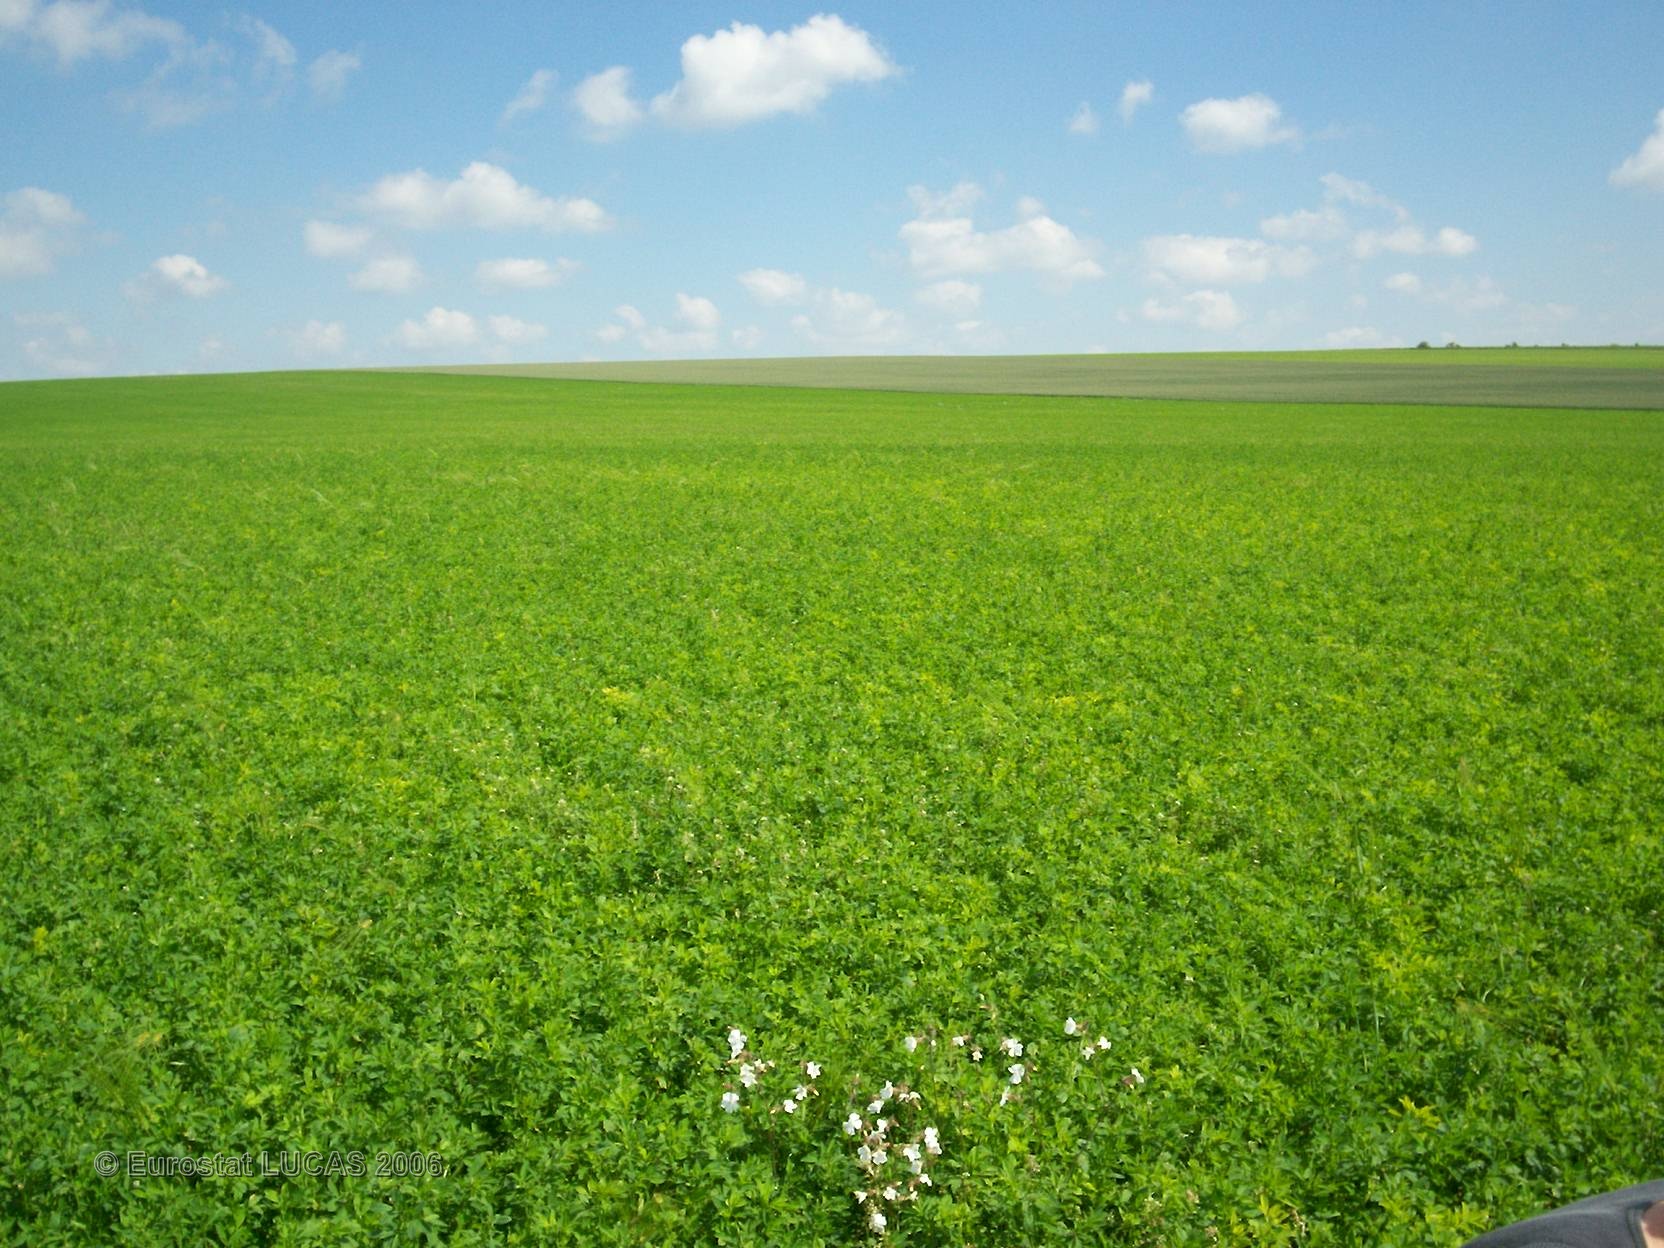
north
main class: Cropland
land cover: Lucerne
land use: Agriculture (excluding fallow land and kitchen gardens)
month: June
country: FR
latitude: 48.8040
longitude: 4.4280
